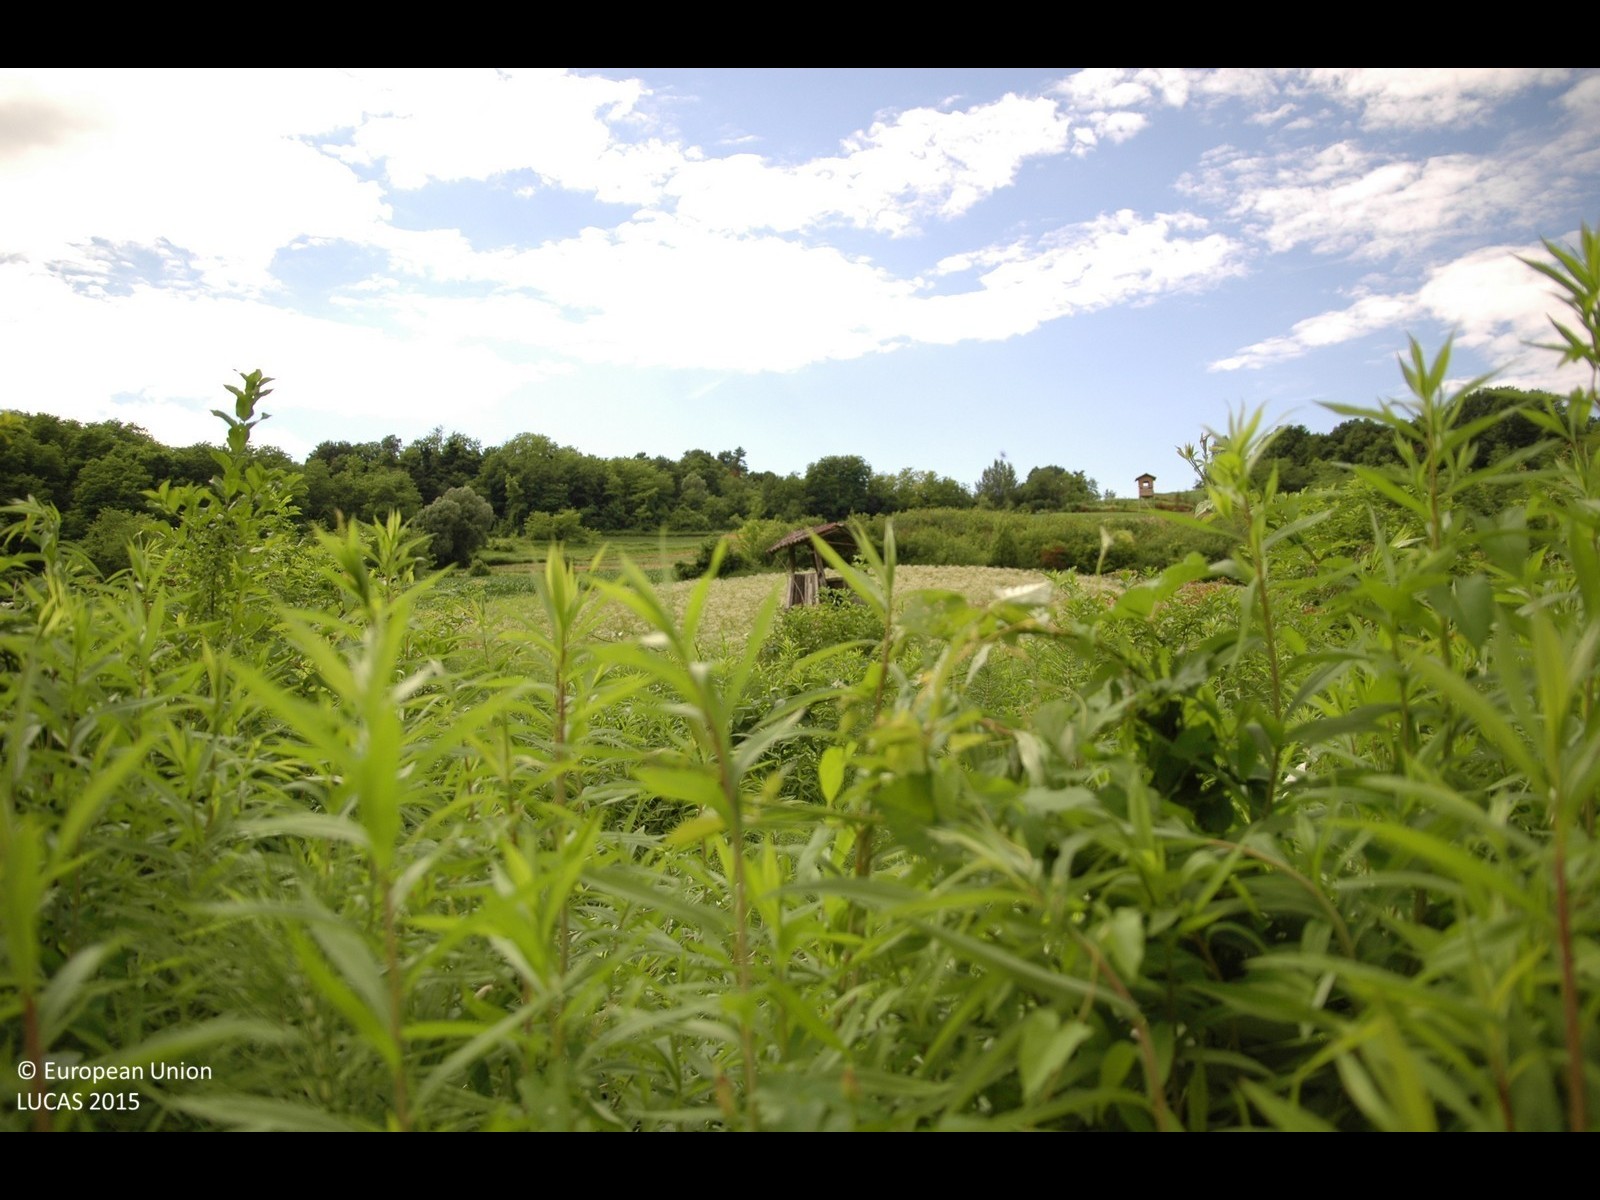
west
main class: Shrubland
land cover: Shrubland without tree cover
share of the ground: > 75 %
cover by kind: shrubs 90 %, herbaceous plants 10 %
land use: Fallow land
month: June
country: HR
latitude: 46.0630
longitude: 15.8802
